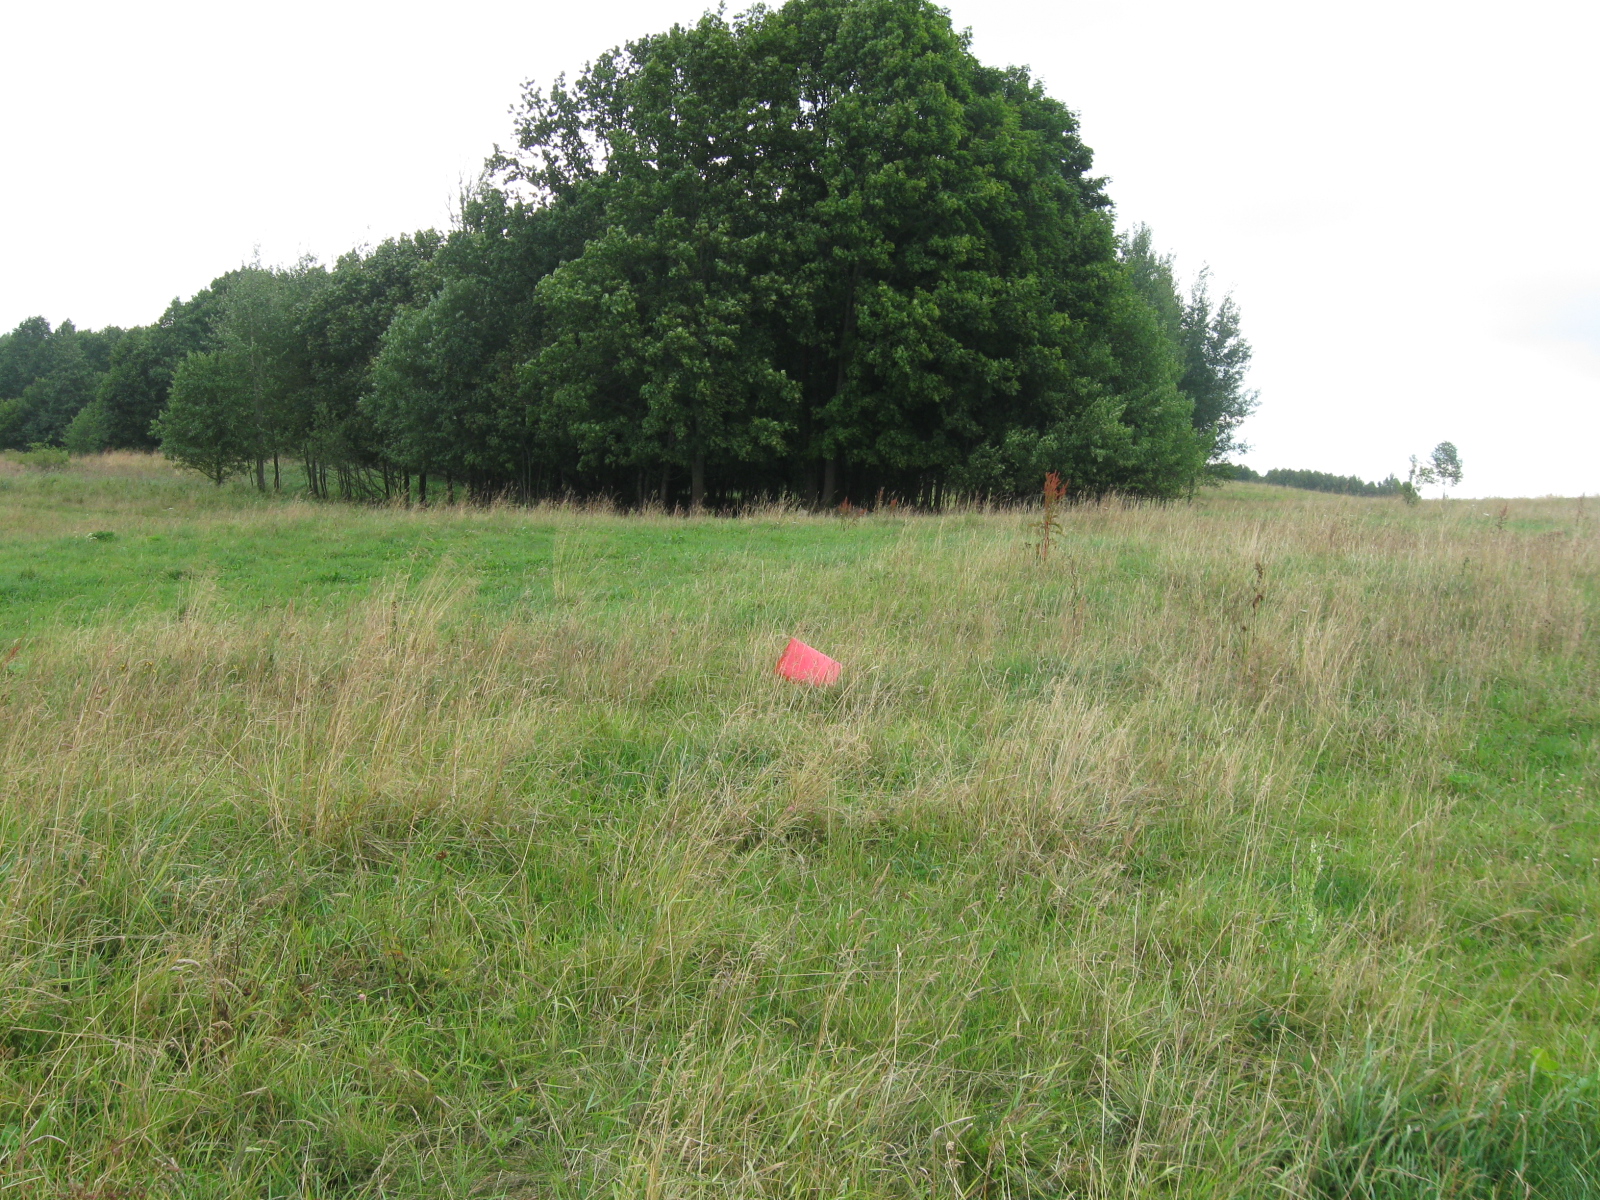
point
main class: Grassland
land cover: Grassland without tree/shrub cover
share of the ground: > 75 %
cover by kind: herbaceous plants 95 %, unconsolidated bare surface 5 %
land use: Agriculture (excluding fallow land and kitchen gardens)
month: July
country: LT
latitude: 54.3953
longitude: 24.2837
